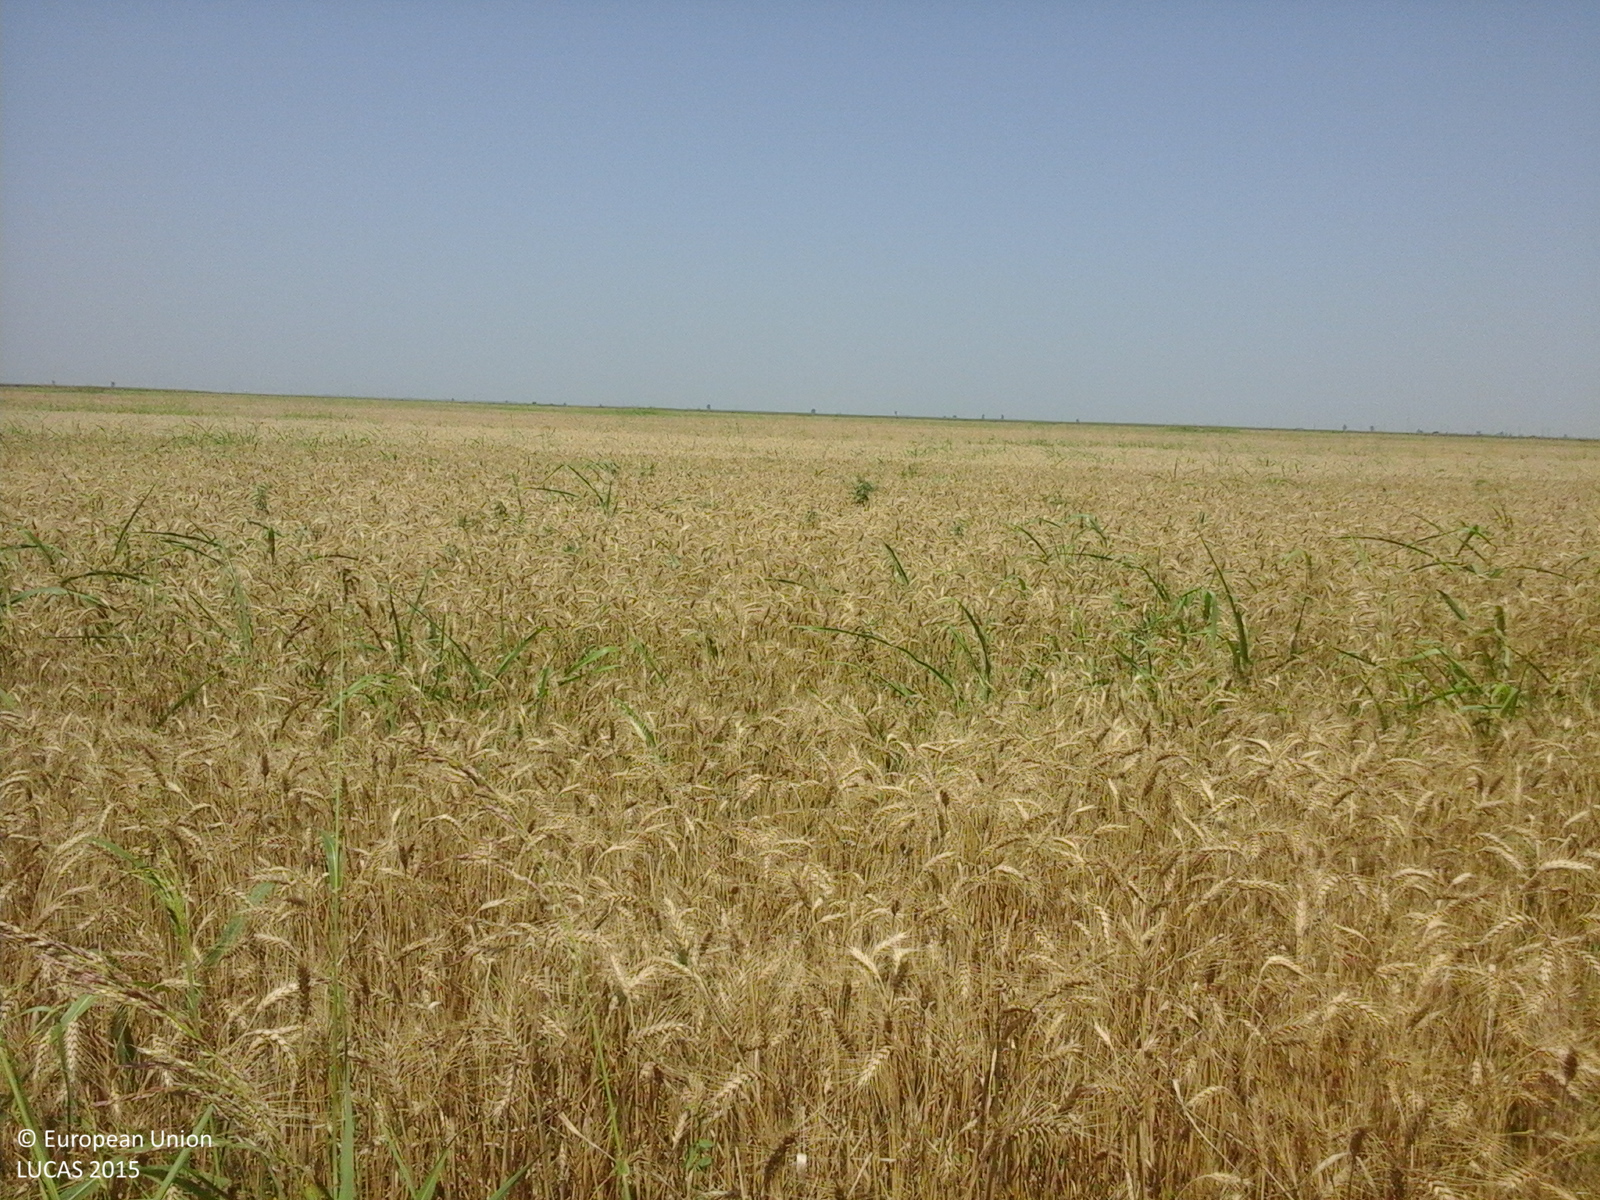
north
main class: Cropland
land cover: Common wheat
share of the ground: > 75 %
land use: Agriculture (excluding fallow land and kitchen gardens)
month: July
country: RO
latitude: 44.7367
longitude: 27.6657
